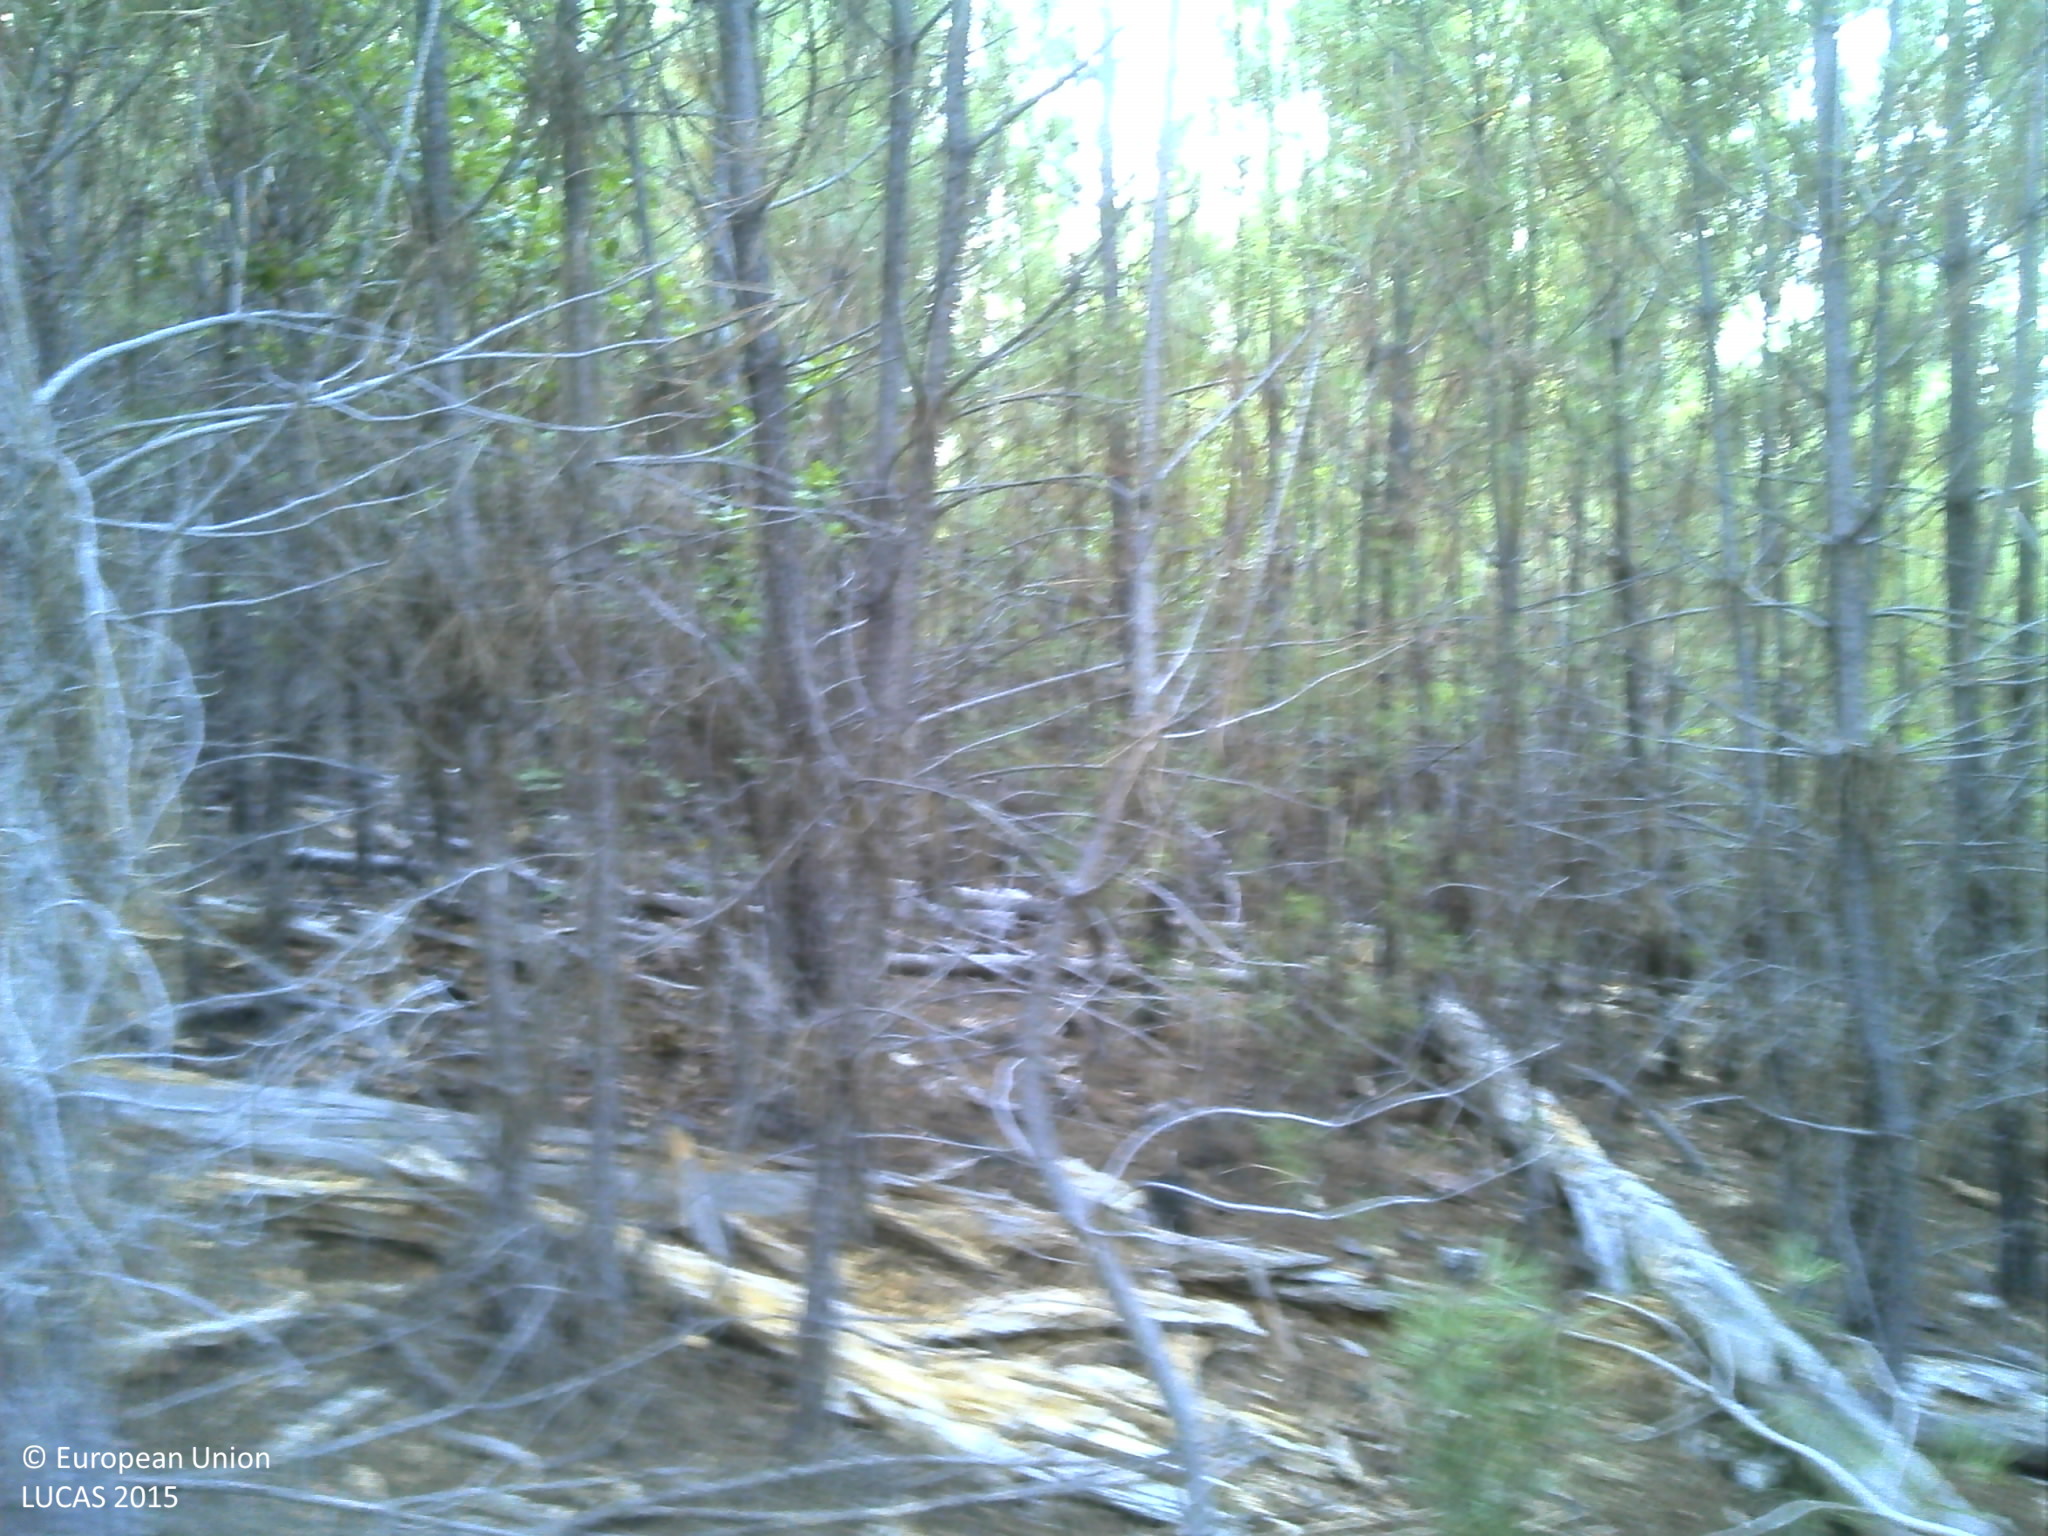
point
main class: Woodland
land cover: Pine dominated coniferous woodland
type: coniferous forest of the mediterranean region
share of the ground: 50 - 75 %
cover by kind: coniferous forest trees 65 %, shrubs 25 %, unconsolidated bare surface 5 %
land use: Forestry
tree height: > 5 m
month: July
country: PT
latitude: 39.9203
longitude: -7.7863
